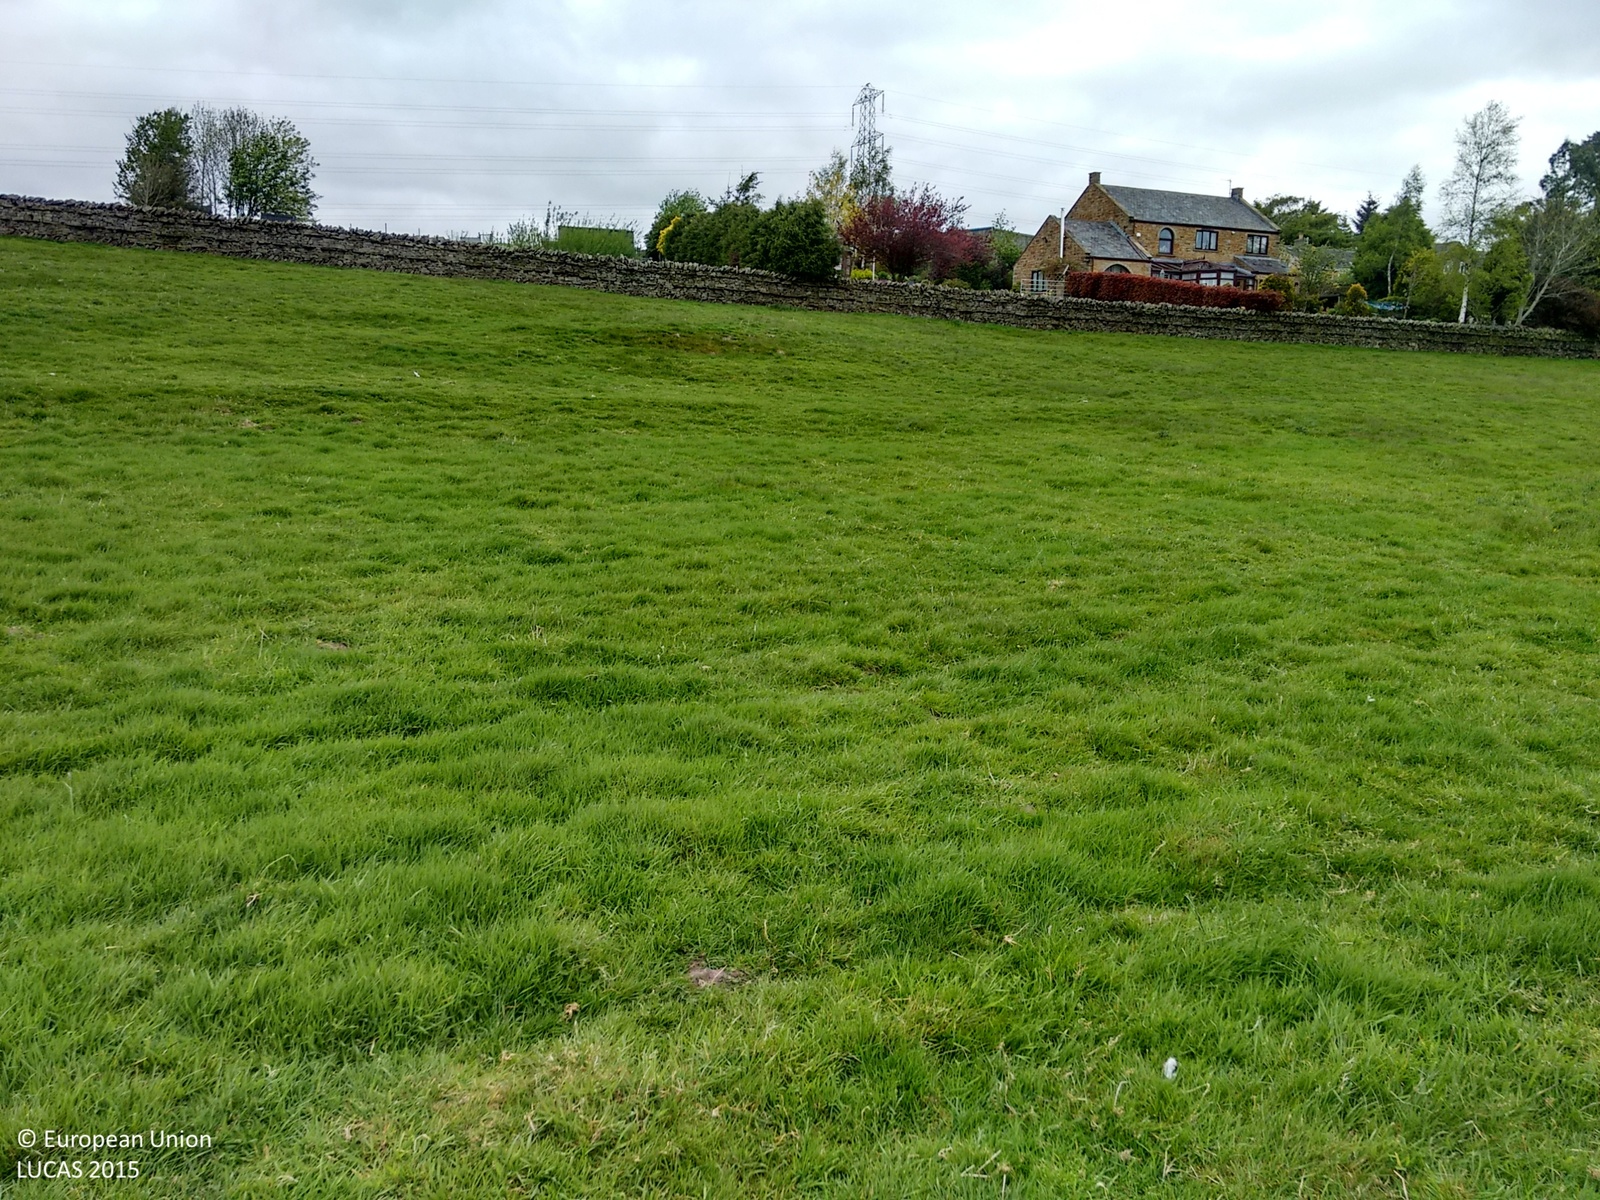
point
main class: Grassland
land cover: Grassland without tree/shrub cover
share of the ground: > 75 %
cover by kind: herbaceous plants 100 %
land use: Agriculture (excluding fallow land and kitchen gardens)
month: May
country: GB
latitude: 54.9773
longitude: -2.4517
